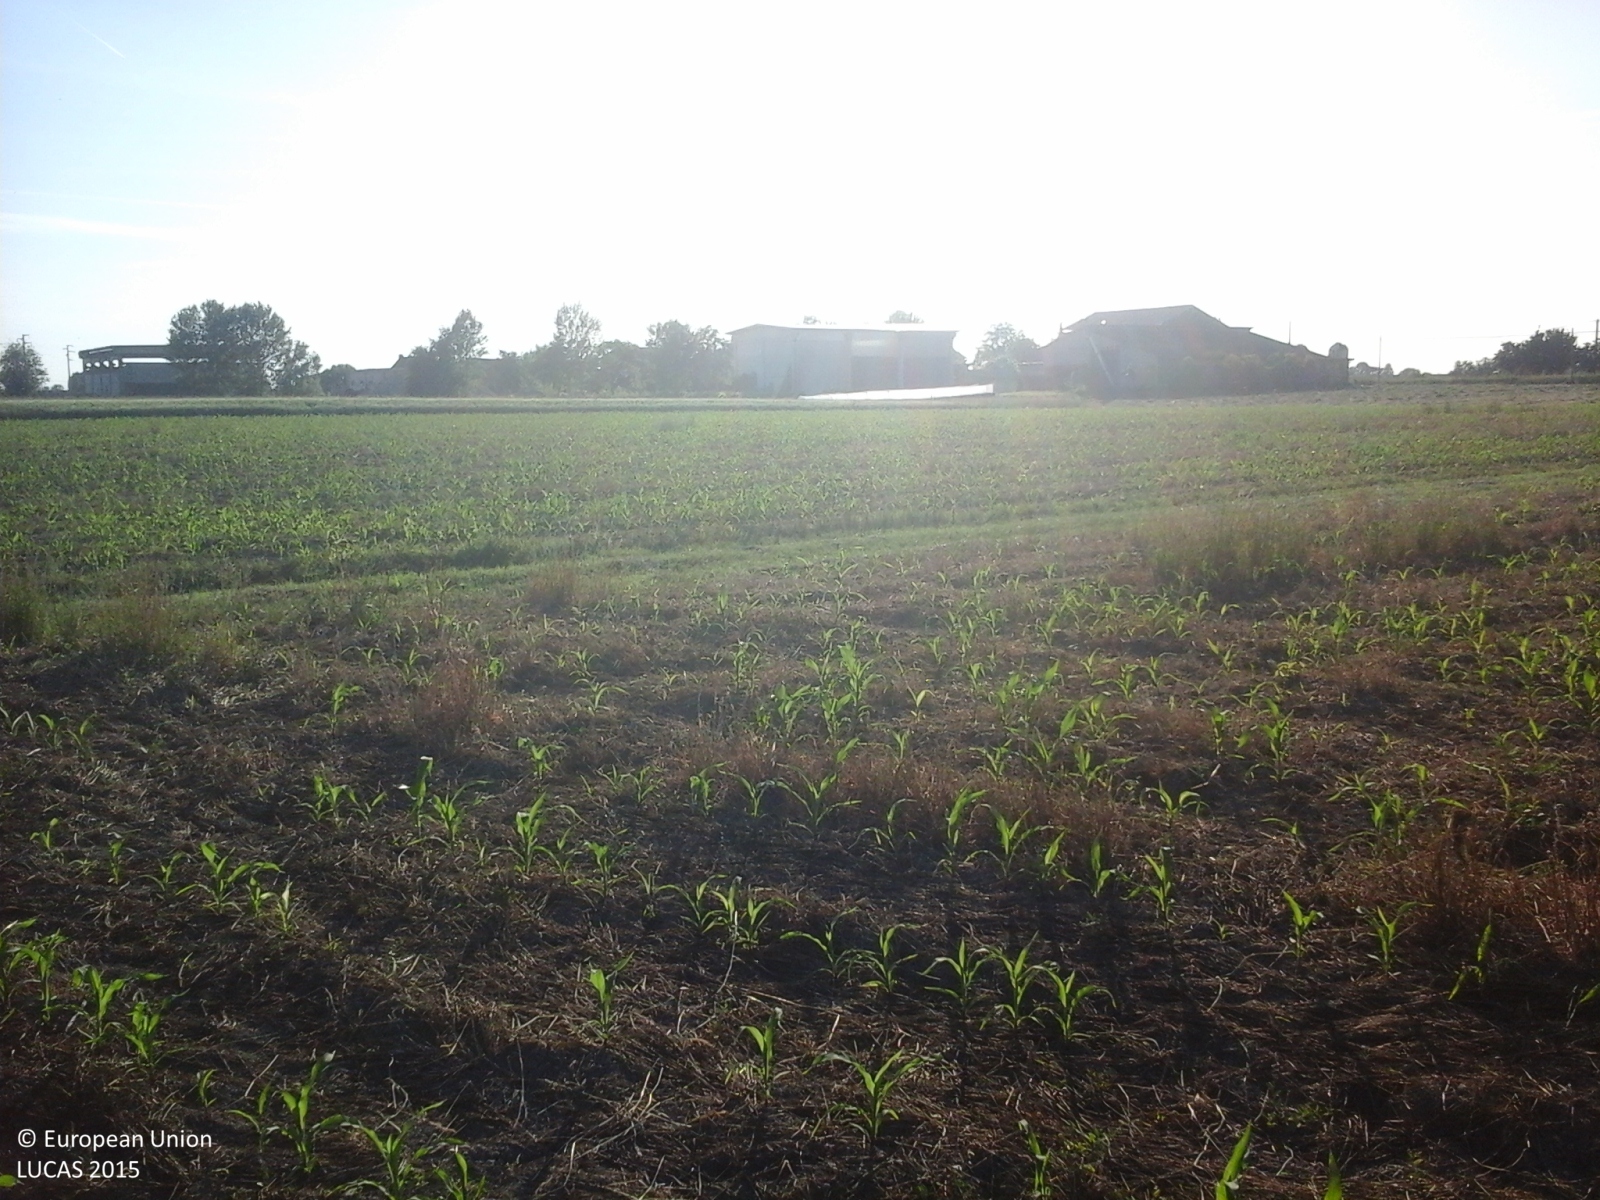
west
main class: Cropland
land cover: Maize
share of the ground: 10 - 25 %
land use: Agriculture (excluding fallow land and kitchen gardens)
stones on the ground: < 10 %
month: May
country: IT
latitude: 44.9591
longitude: 10.9742
